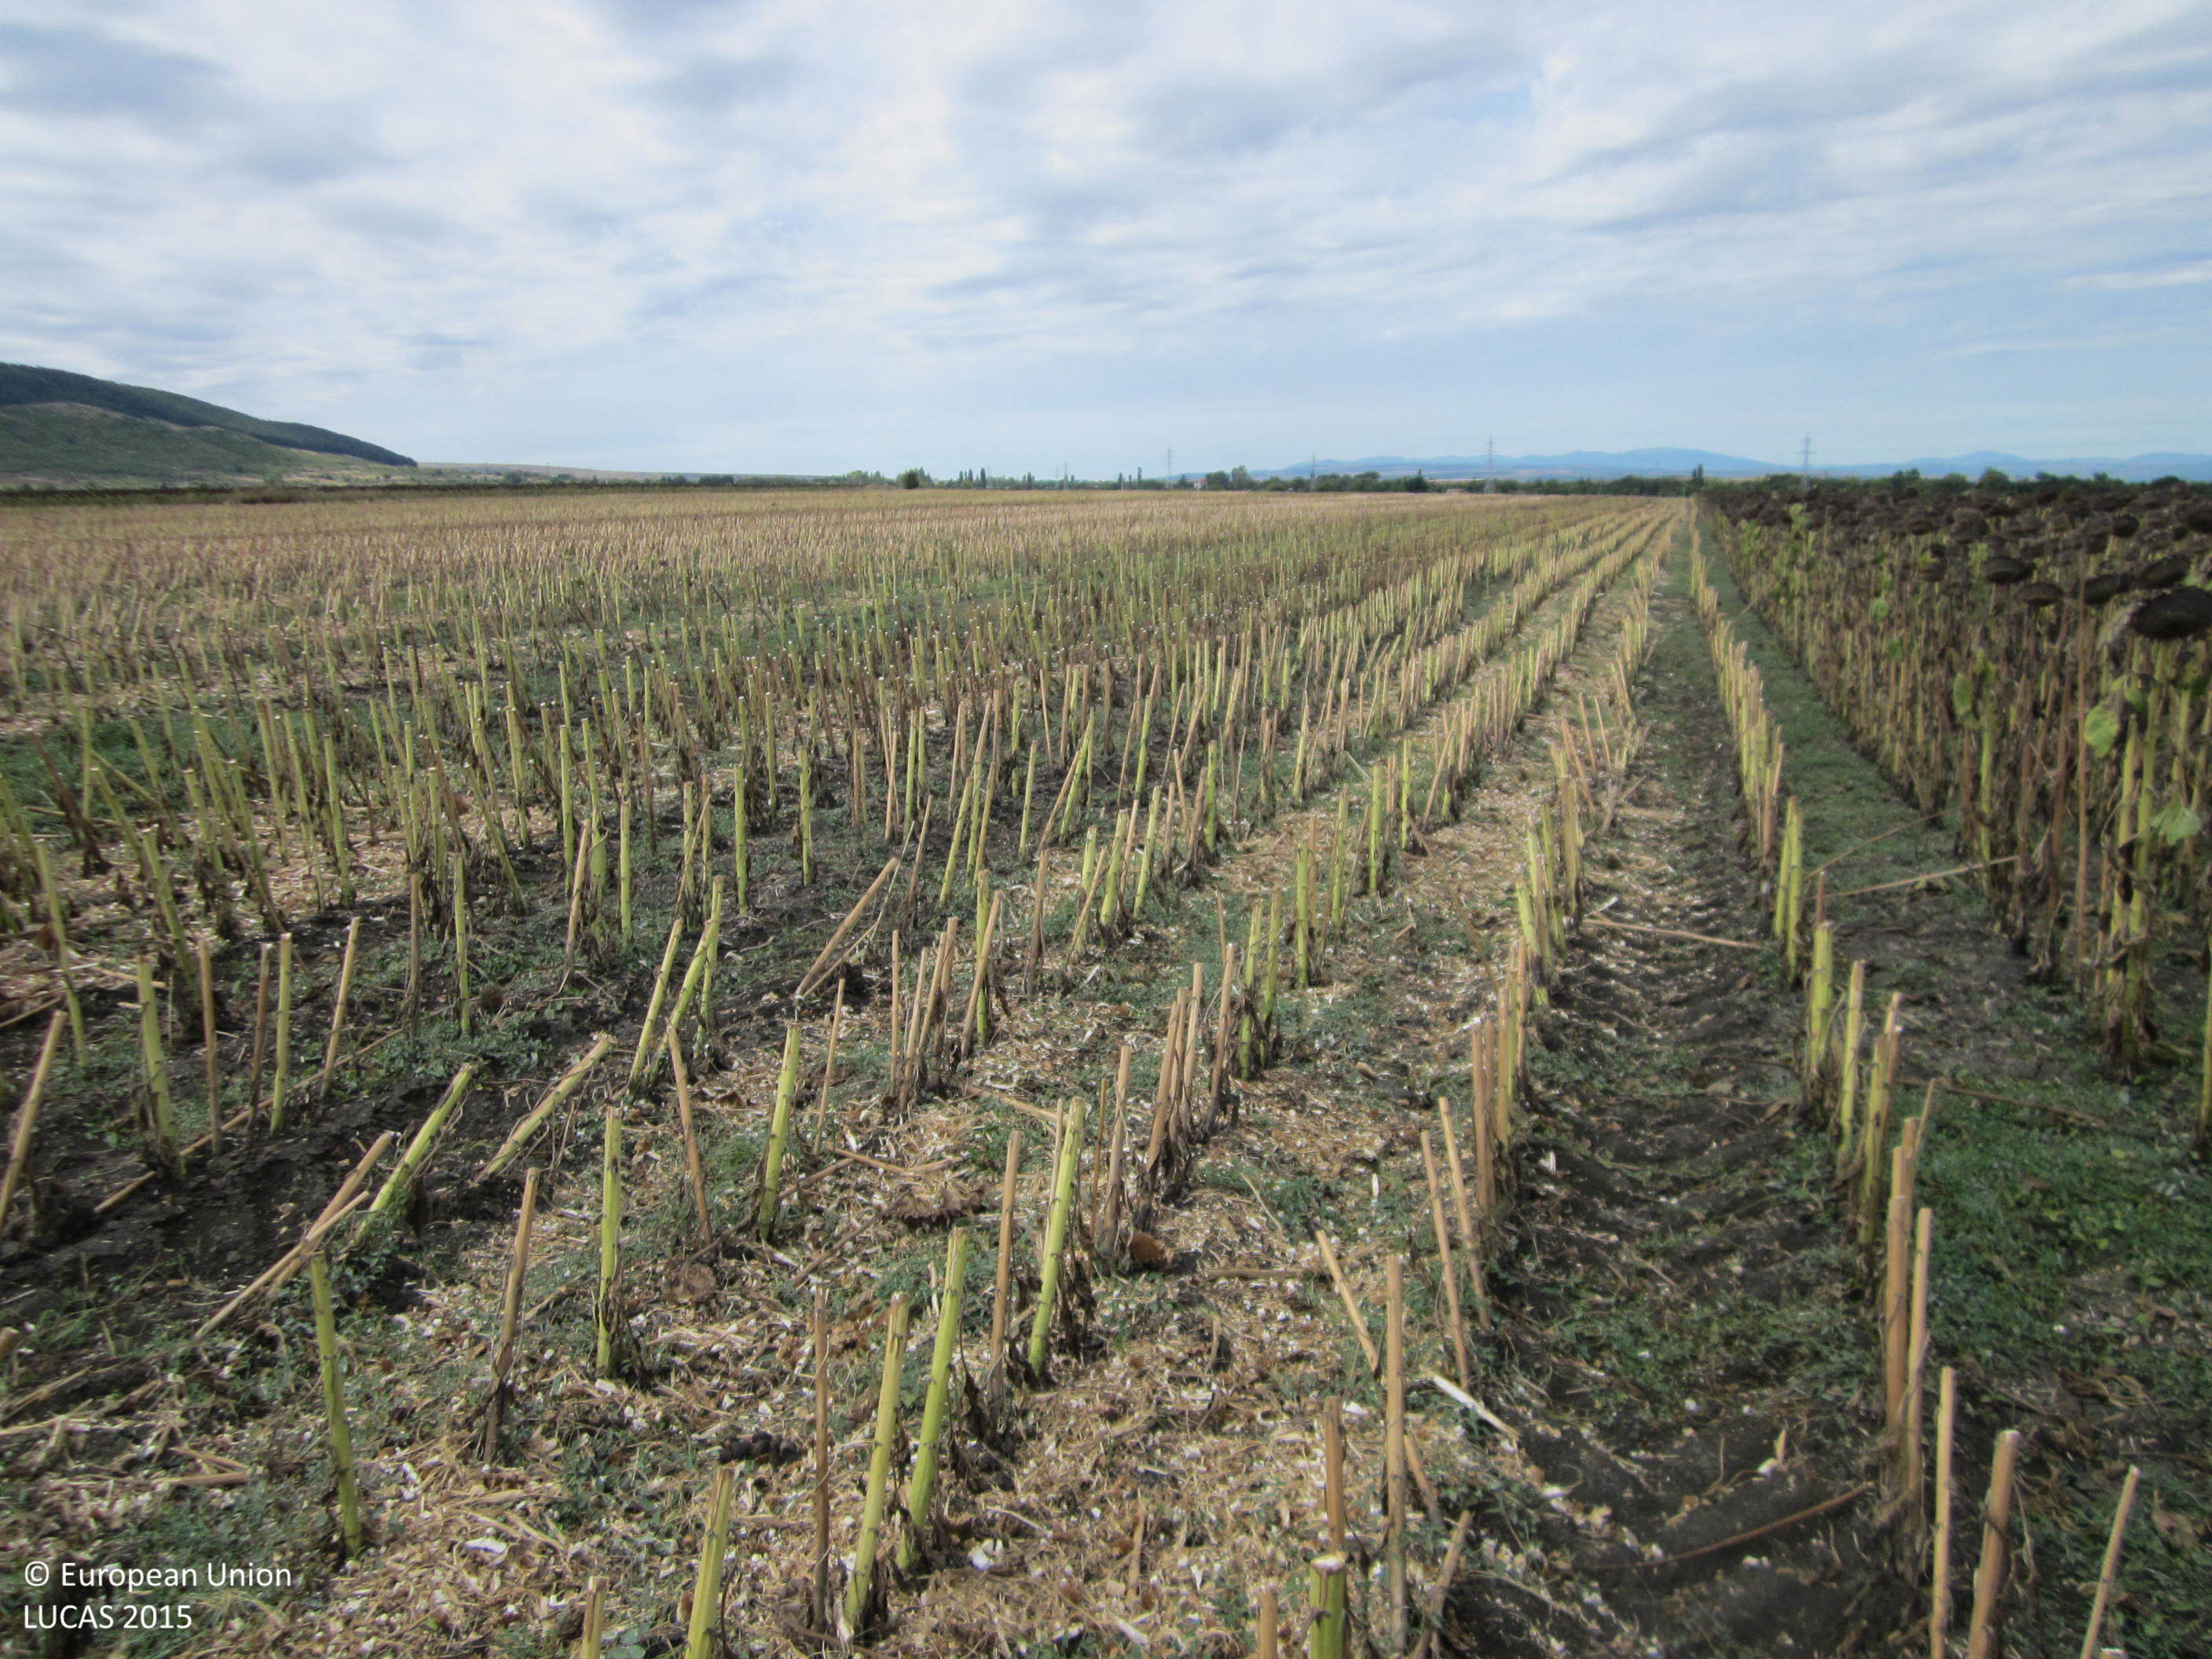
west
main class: Cropland
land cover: Sunflower
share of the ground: > 75 %
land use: Agriculture (excluding fallow land and kitchen gardens)
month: September
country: BG
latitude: 42.6546
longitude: 27.0269
